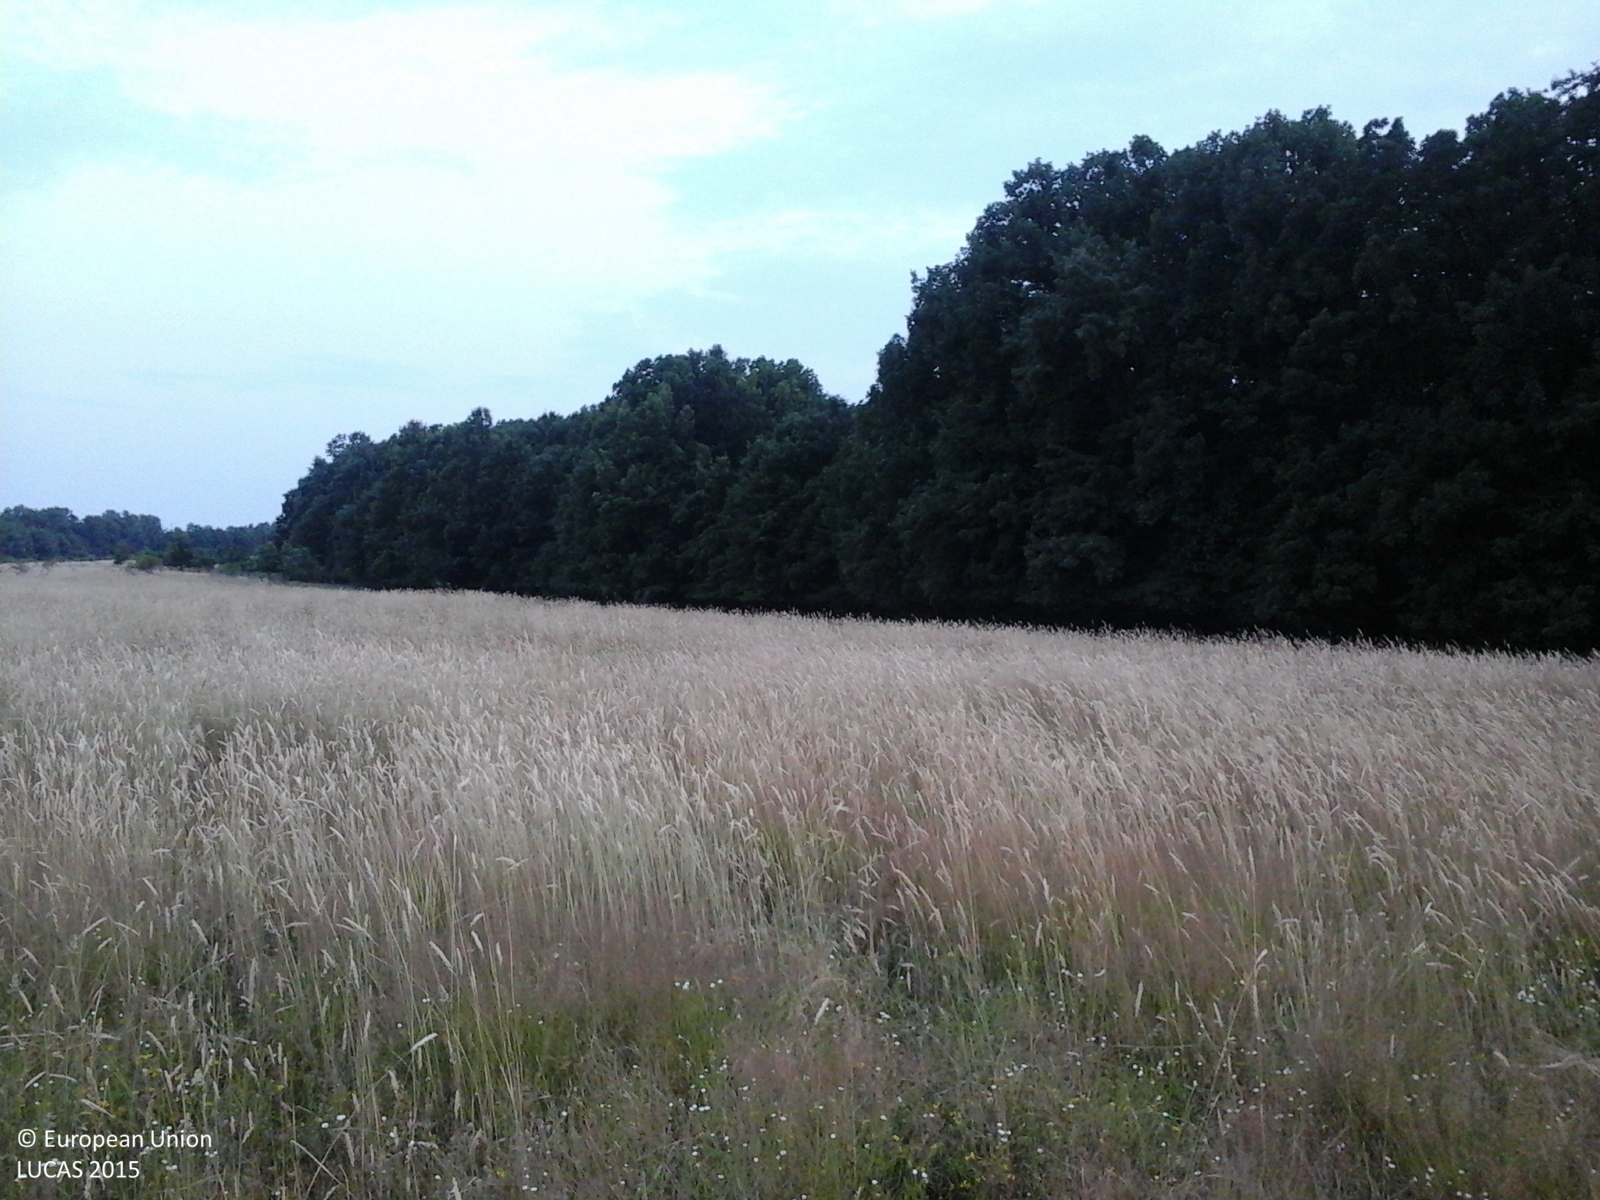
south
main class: Grassland
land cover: Grassland without tree/shrub cover
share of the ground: > 75 %
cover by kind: herbaceous plants 100 %
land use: Agriculture (excluding fallow land and kitchen gardens)
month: July
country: RO
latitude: 44.9103
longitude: 24.5531
